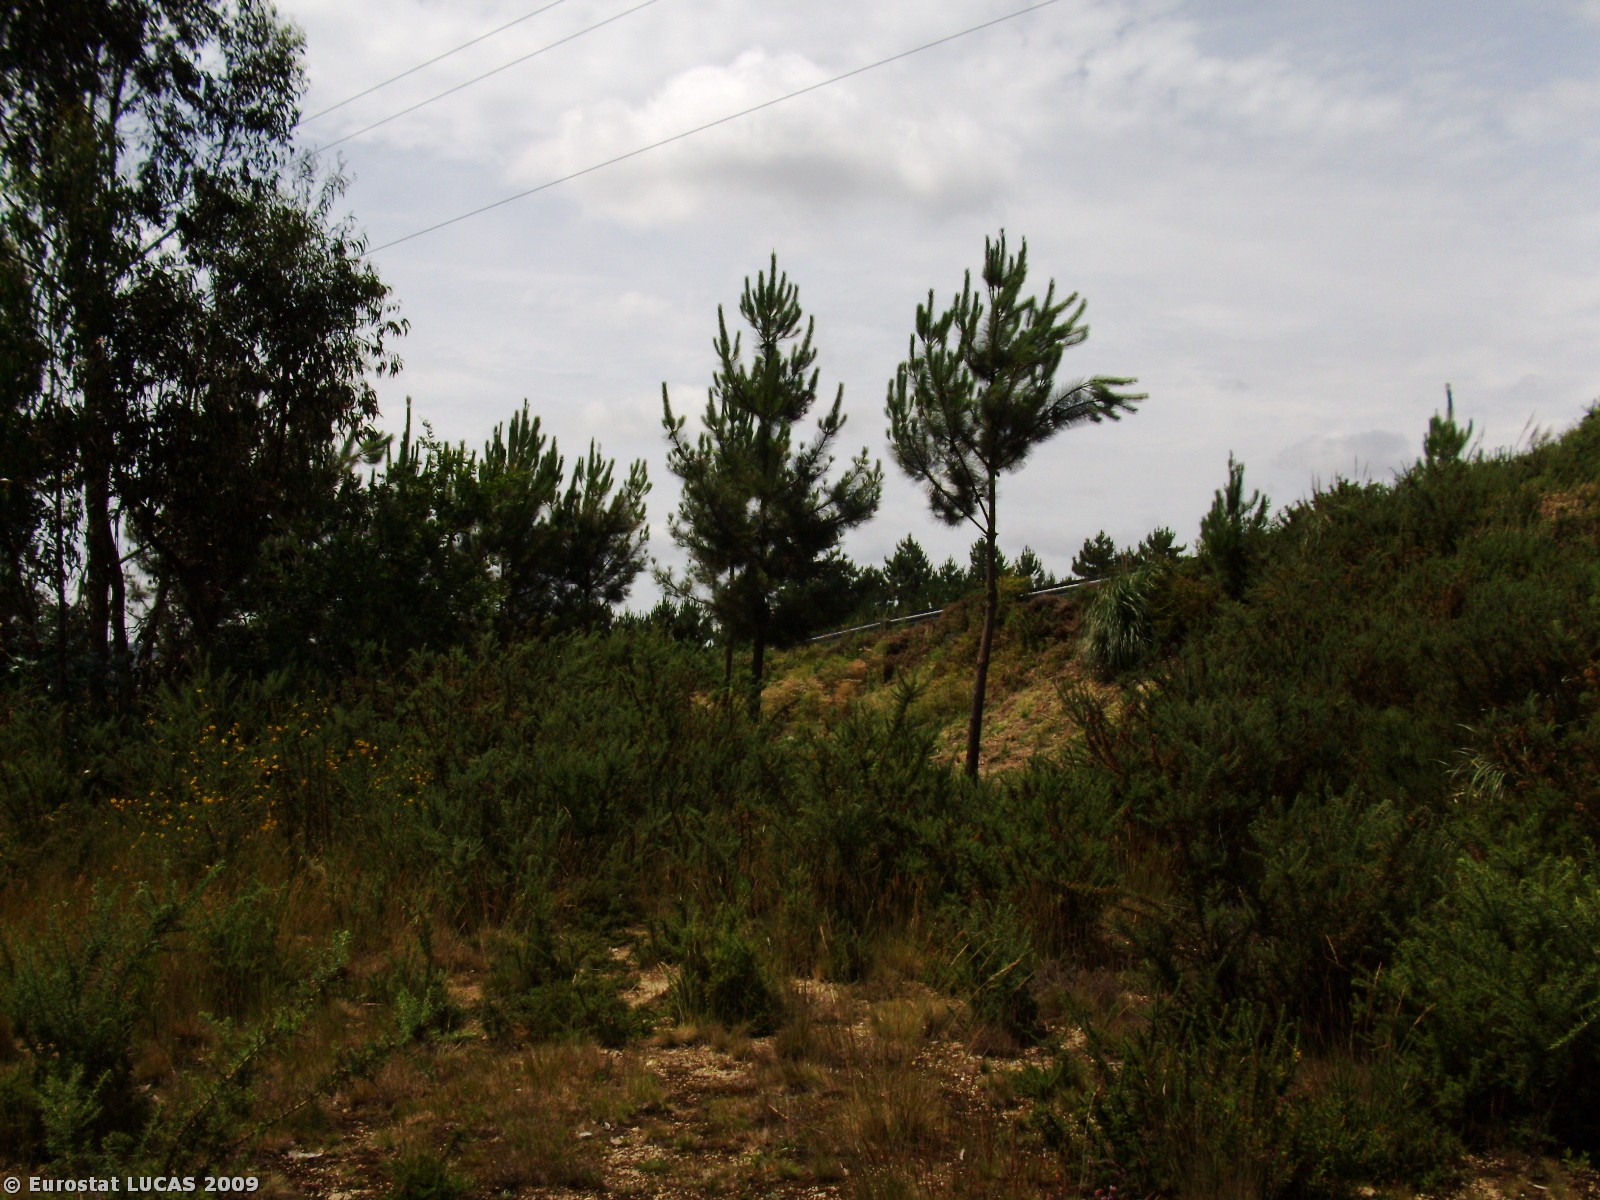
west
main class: Grassland
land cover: Spontaneously vegetated surfaces
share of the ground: 10 - 25 %
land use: Unused
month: June
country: PT
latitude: 41.5272
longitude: -8.5782
